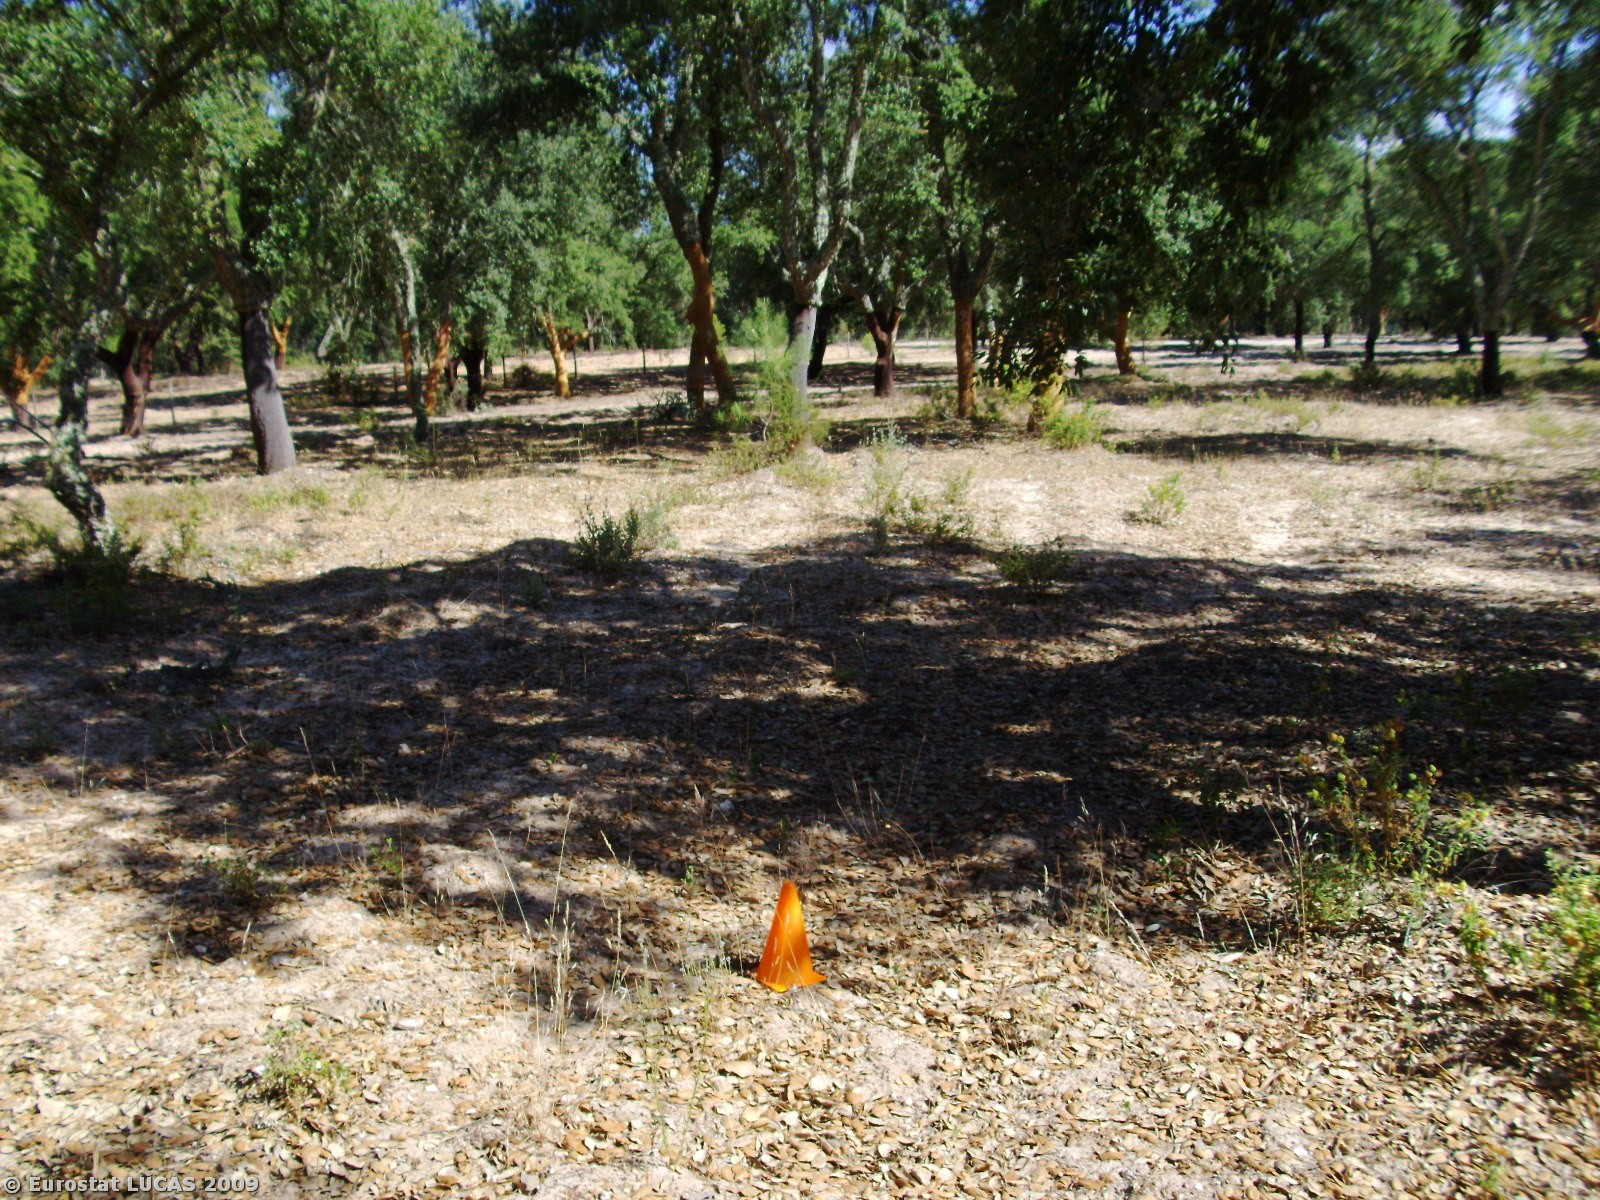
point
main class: Woodland
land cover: Broadleaved woodland
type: broadleaved evergreen forest
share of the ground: 25 - 50 %
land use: Forestry
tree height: > 5 m
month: June
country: PT
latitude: 38.2187
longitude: -8.6581
